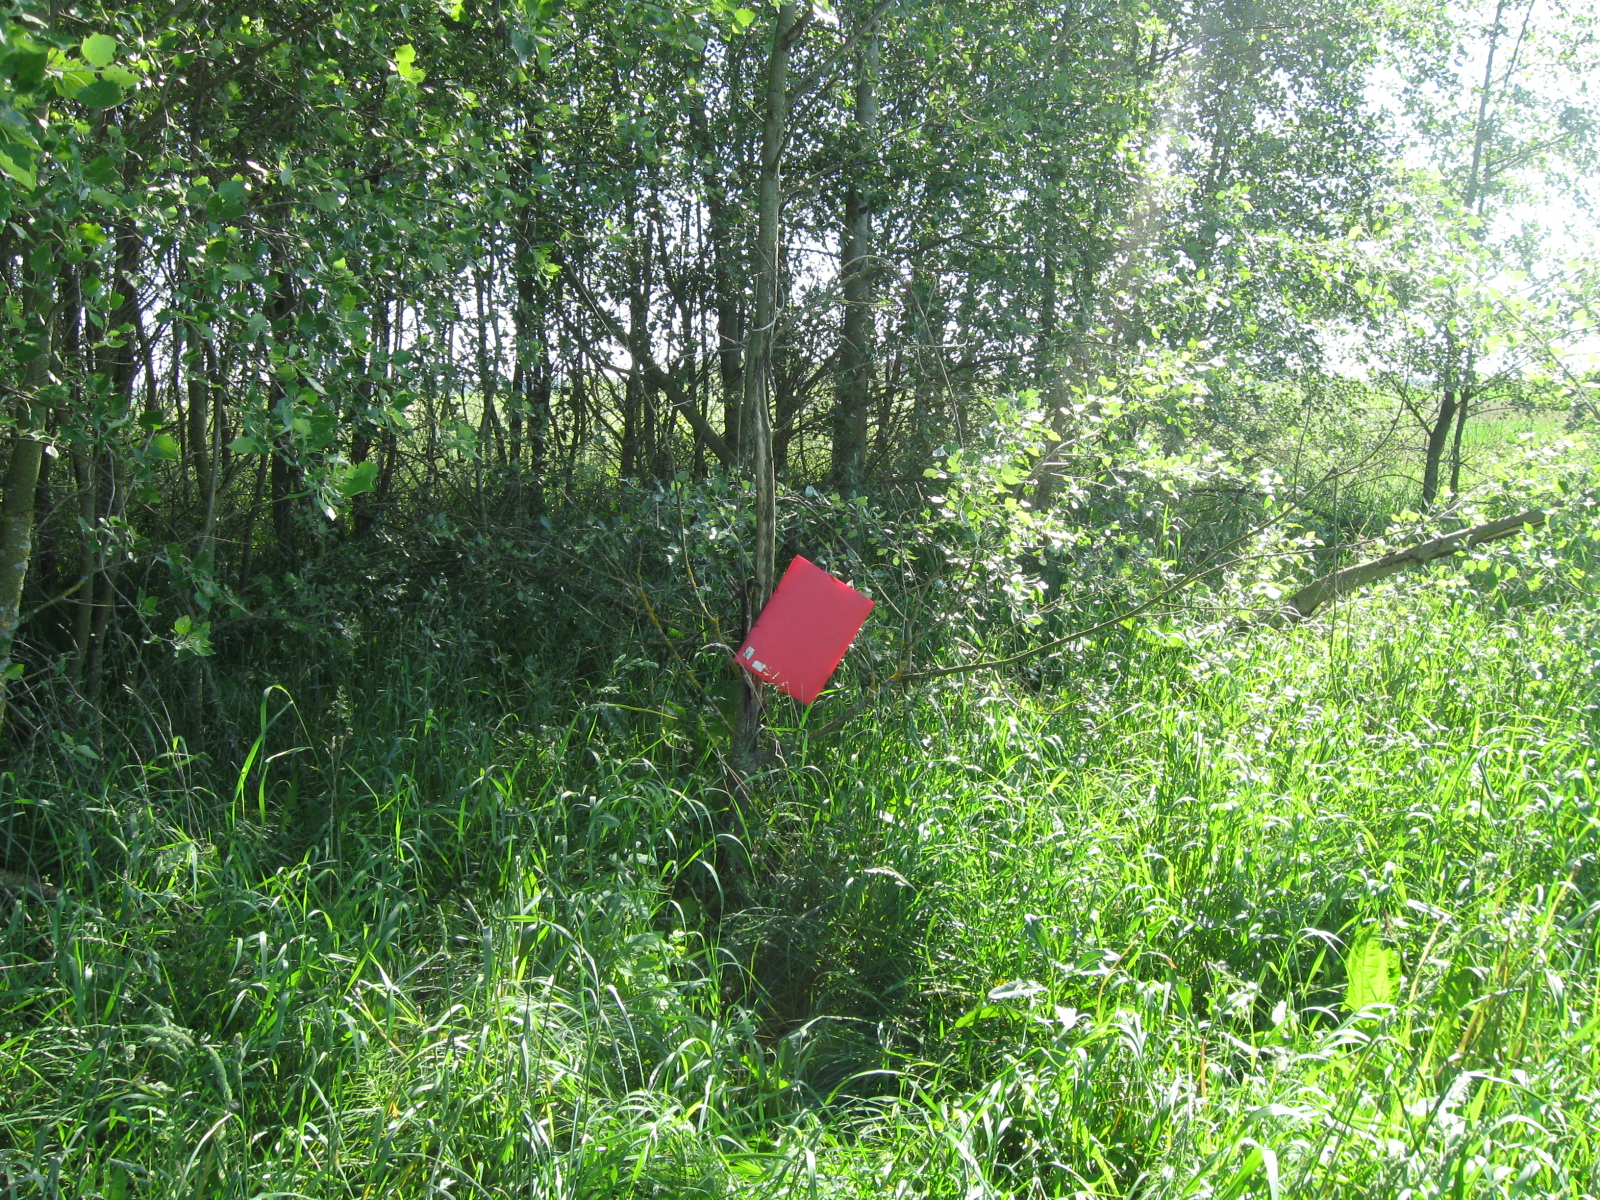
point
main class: Cropland
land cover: Common wheat
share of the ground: > 75 %
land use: Agriculture (excluding fallow land and kitchen gardens)
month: June
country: LT
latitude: 54.8168
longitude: 23.9562
